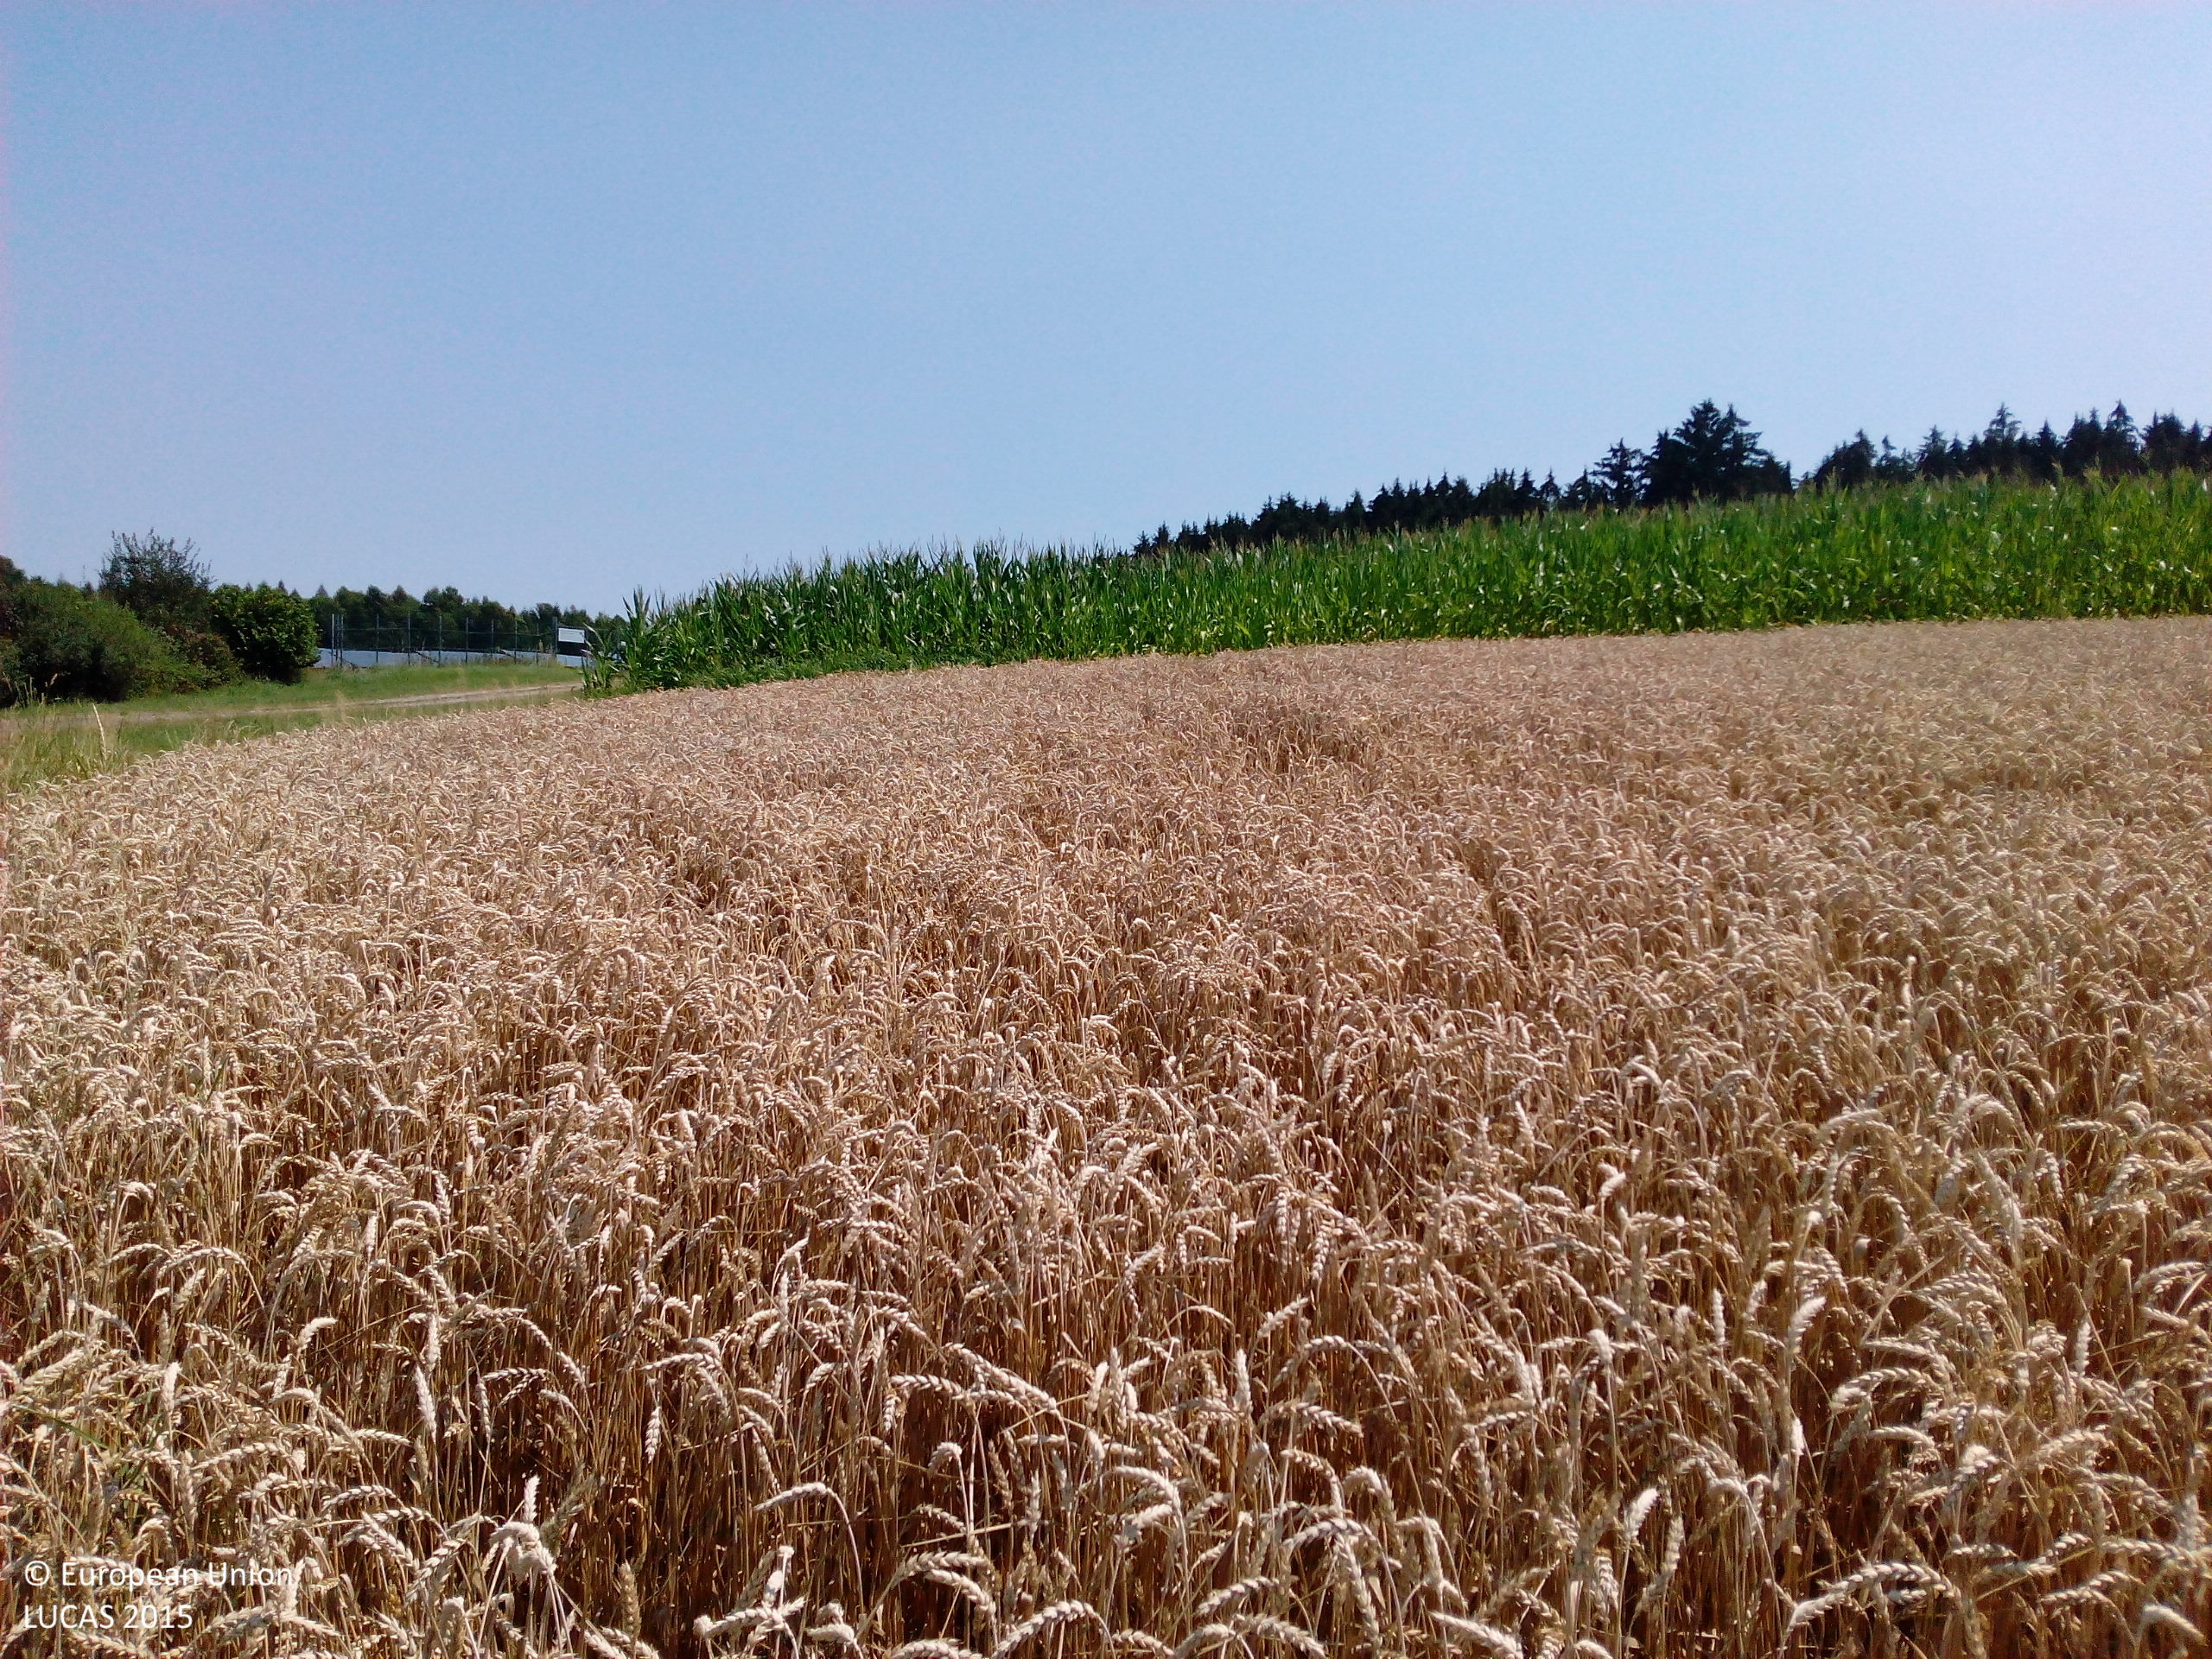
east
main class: Cropland
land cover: Maize
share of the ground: > 75 %
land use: Agriculture (excluding fallow land and kitchen gardens)
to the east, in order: Maize; Other bare soil; Grassland without tree/shrub cover; Tracks; Spruce dominated coniferous woodland; Tracks; Spruce dominated coniferous woodland
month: July
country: DE
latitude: 48.4546
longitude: 12.9334
